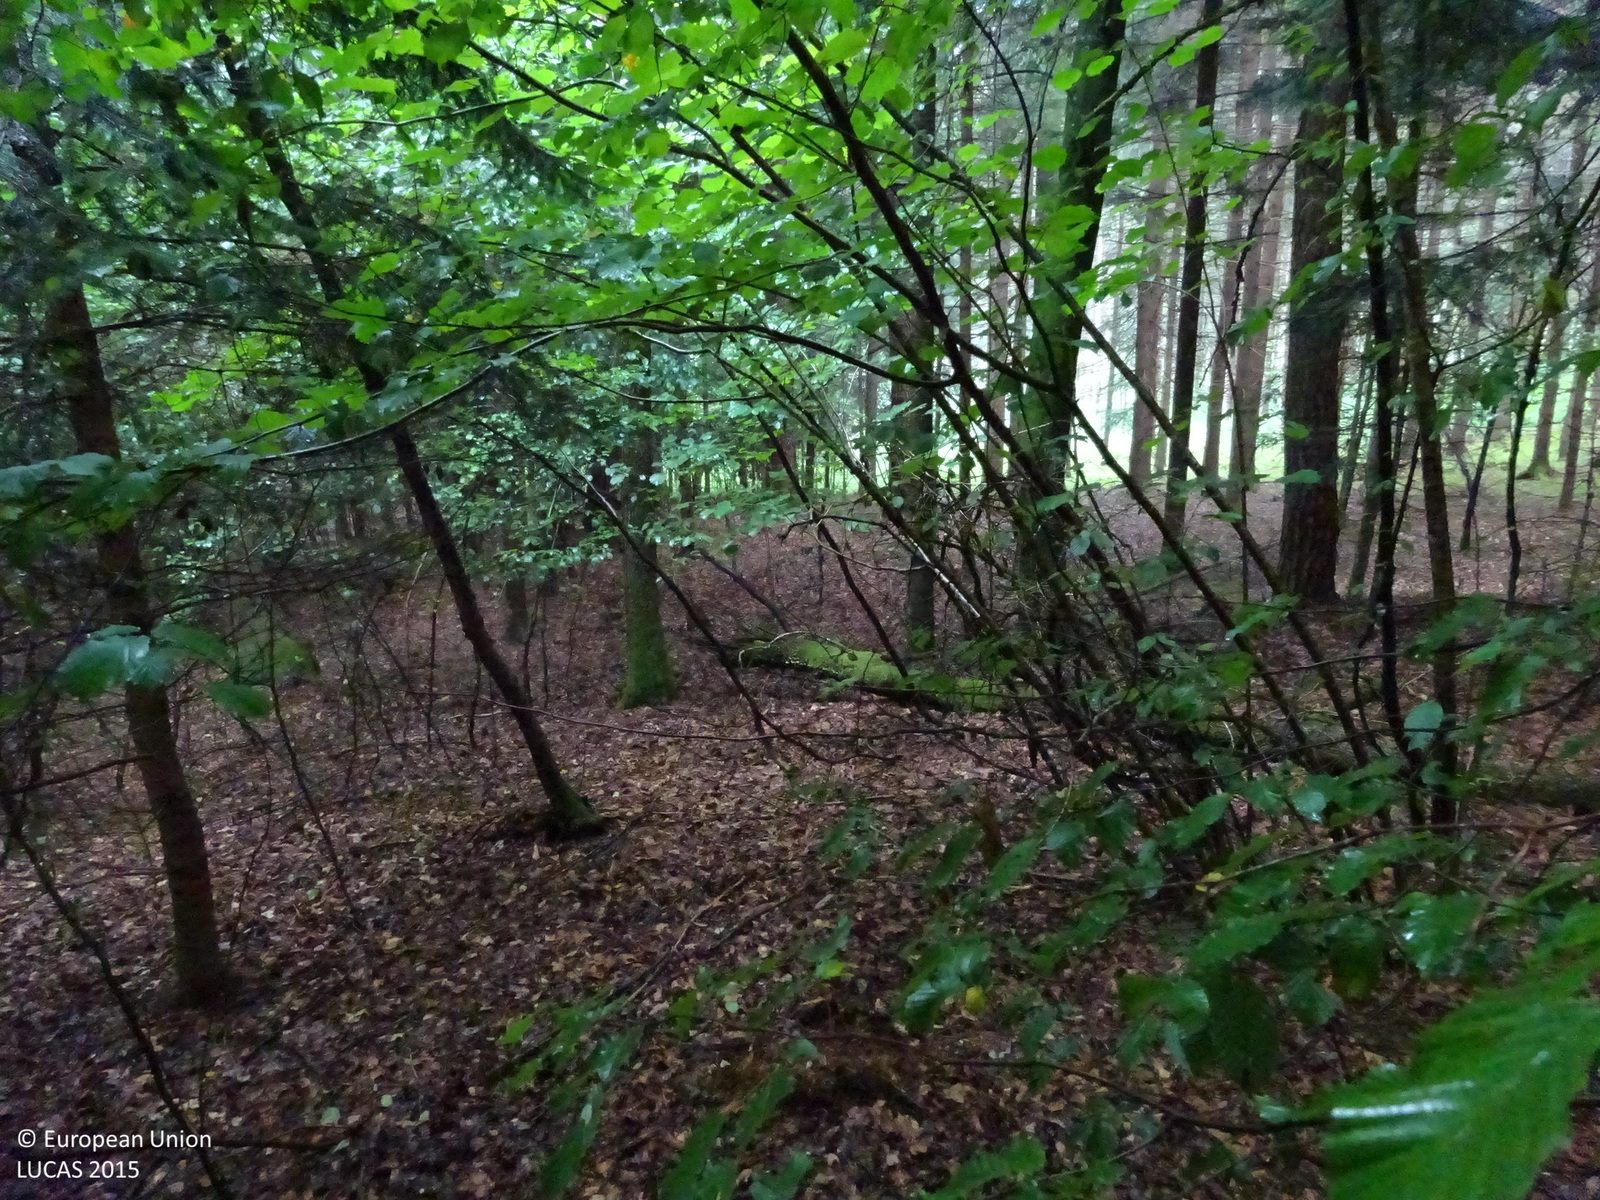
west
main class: Woodland
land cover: Spruce dominated mixed woodland
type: mountainous beech forest
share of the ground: > 75 %
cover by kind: coniferous forest trees 40 %, broadleaved forest trees 40 %, shrubs 20 %
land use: Forestry
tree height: > 5 m
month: July
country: AT
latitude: 46.8343
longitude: 15.2827
